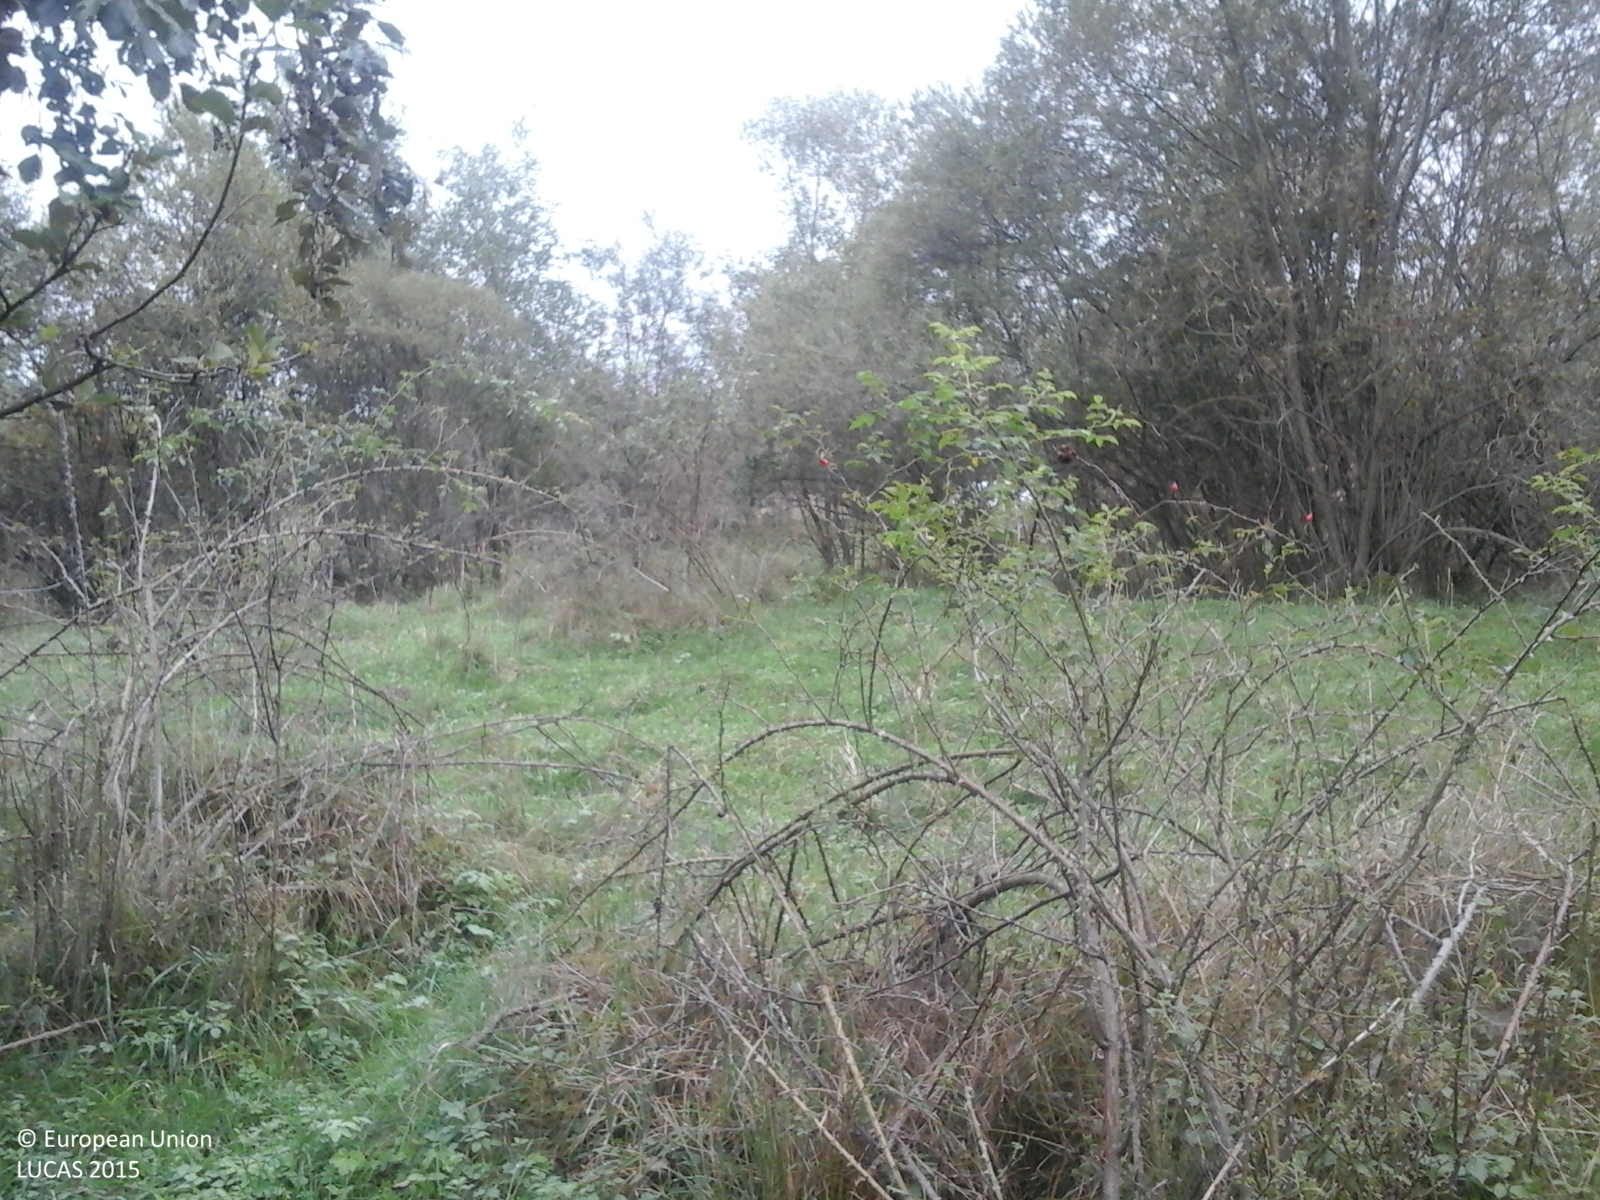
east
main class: Woodland
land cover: Other mixed woodland
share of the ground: > 75 %
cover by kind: broadleaved forest trees 65 %, coniferous forest trees 25 %, herbaceous plants 10 %
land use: Forestry
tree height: < 5 m
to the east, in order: Other mixed woodland; Grassland with sparse tree/shrub cover; Tracks; Grassland with sparse tree/shrub cover; Abandoned hedges; Rivers and streams; Abandoned hedges; Grassland without tree/shrub cover; Ditches and canals; Grassland with sparse tree/shrub cover
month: October
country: RO
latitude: 45.7140
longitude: 24.8225
